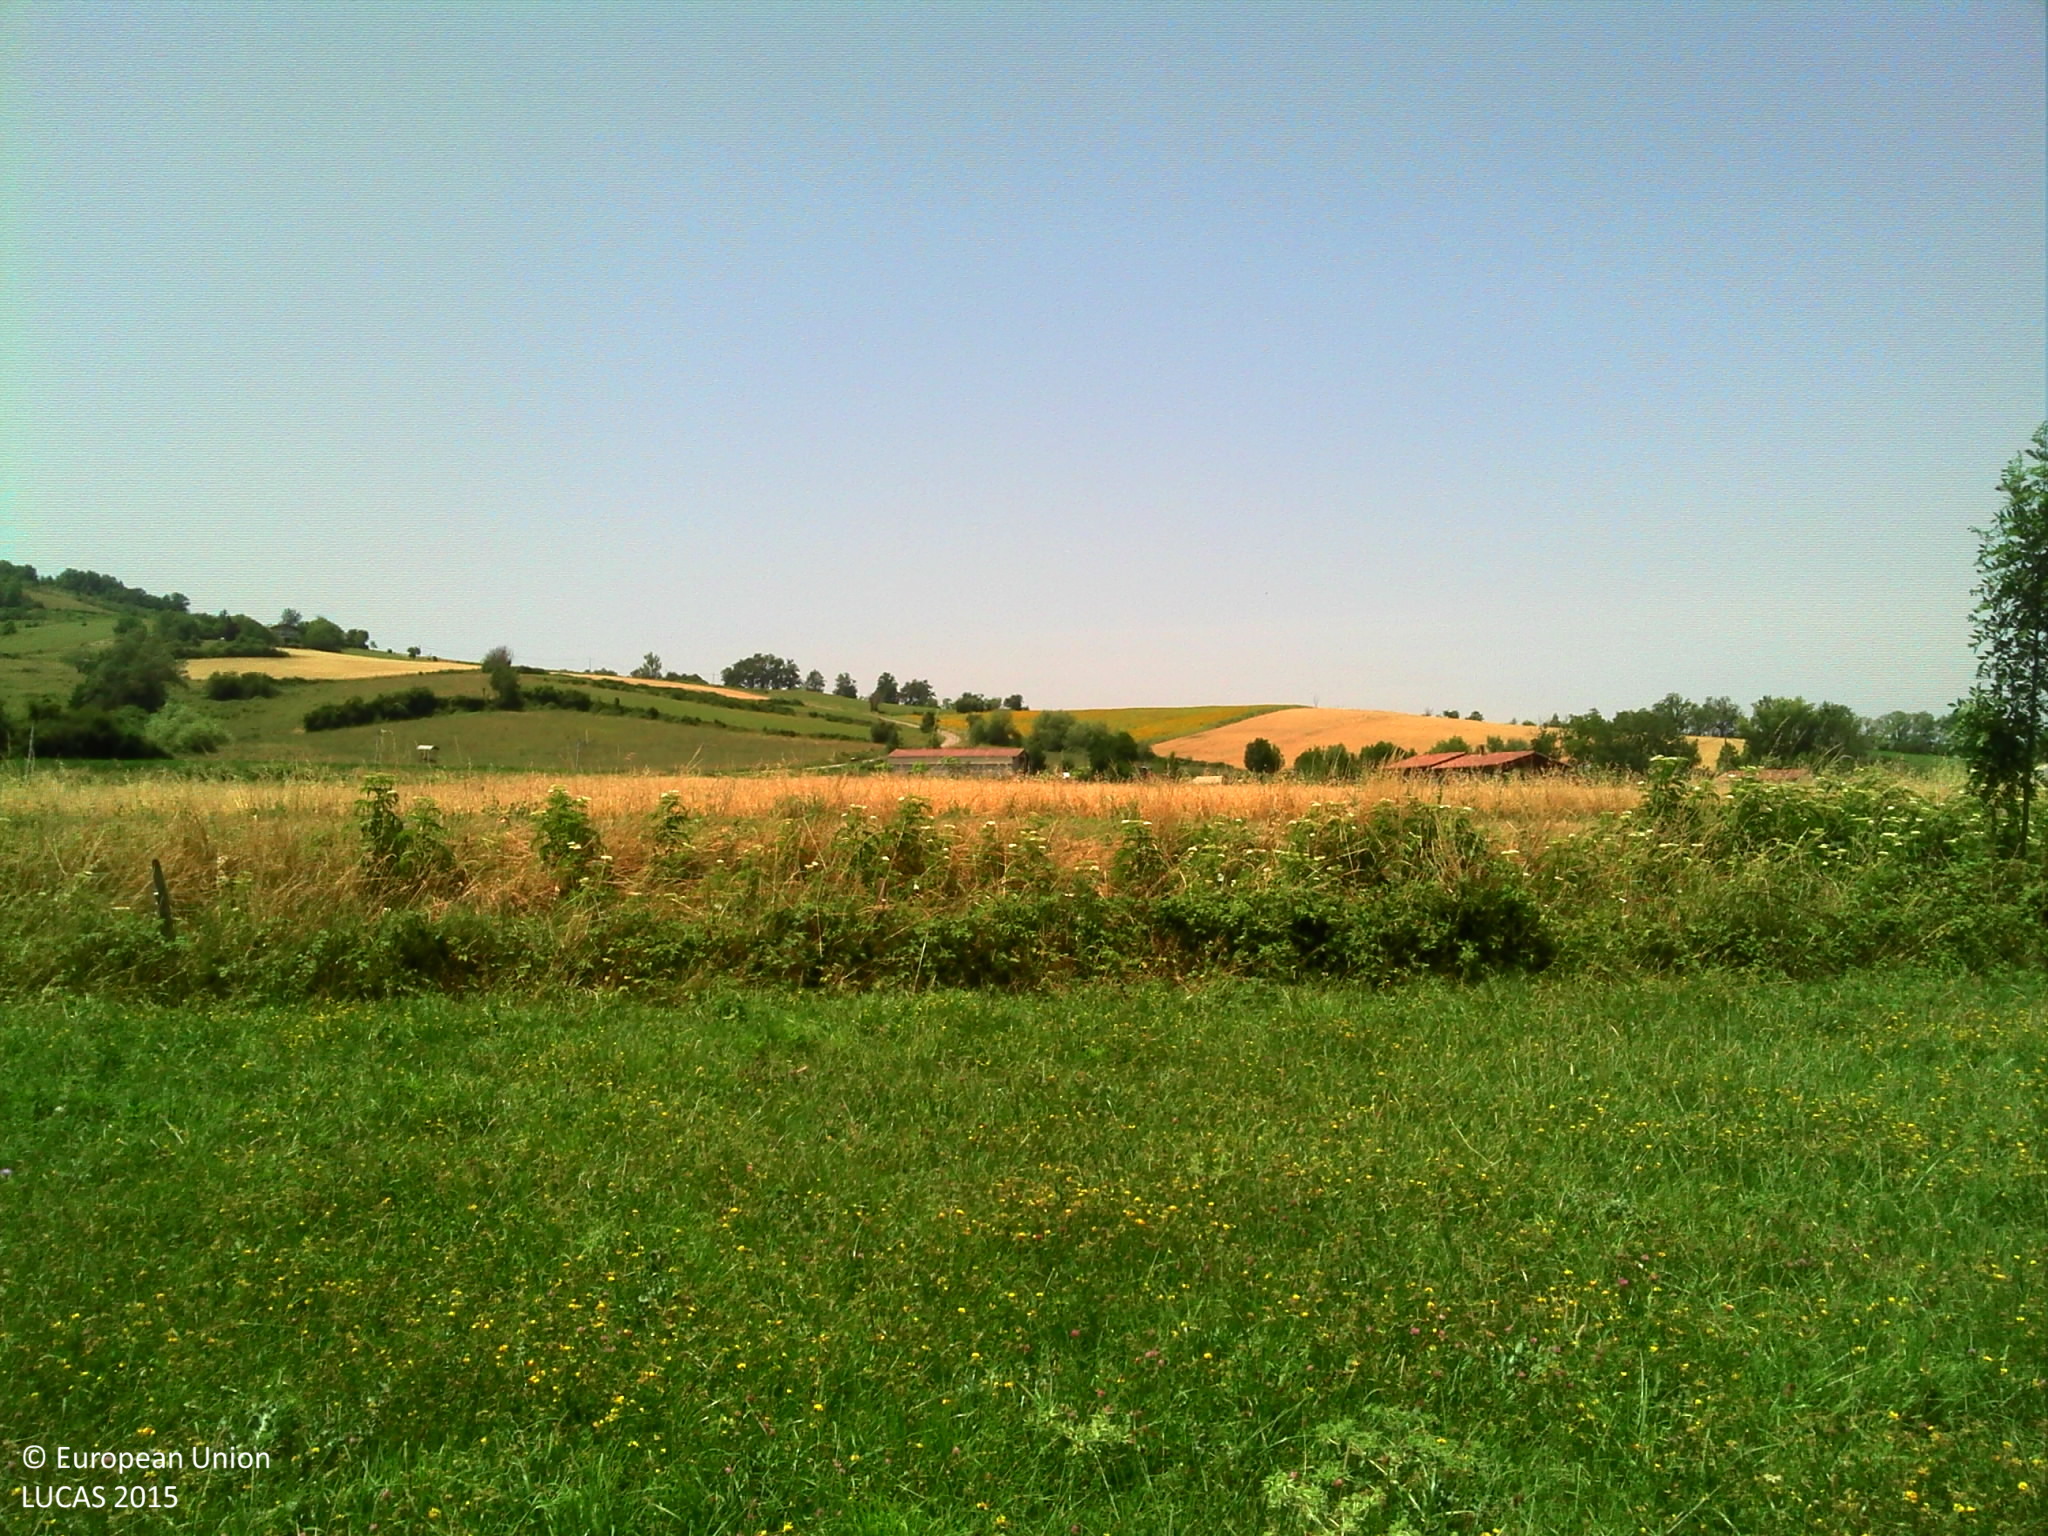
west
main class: Grassland
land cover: Grassland without tree/shrub cover
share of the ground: > 75 %
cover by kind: herbaceous plants 100 %
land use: Agriculture (excluding fallow land and kitchen gardens)
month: July
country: FR
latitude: 43.1078
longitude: 1.4405
